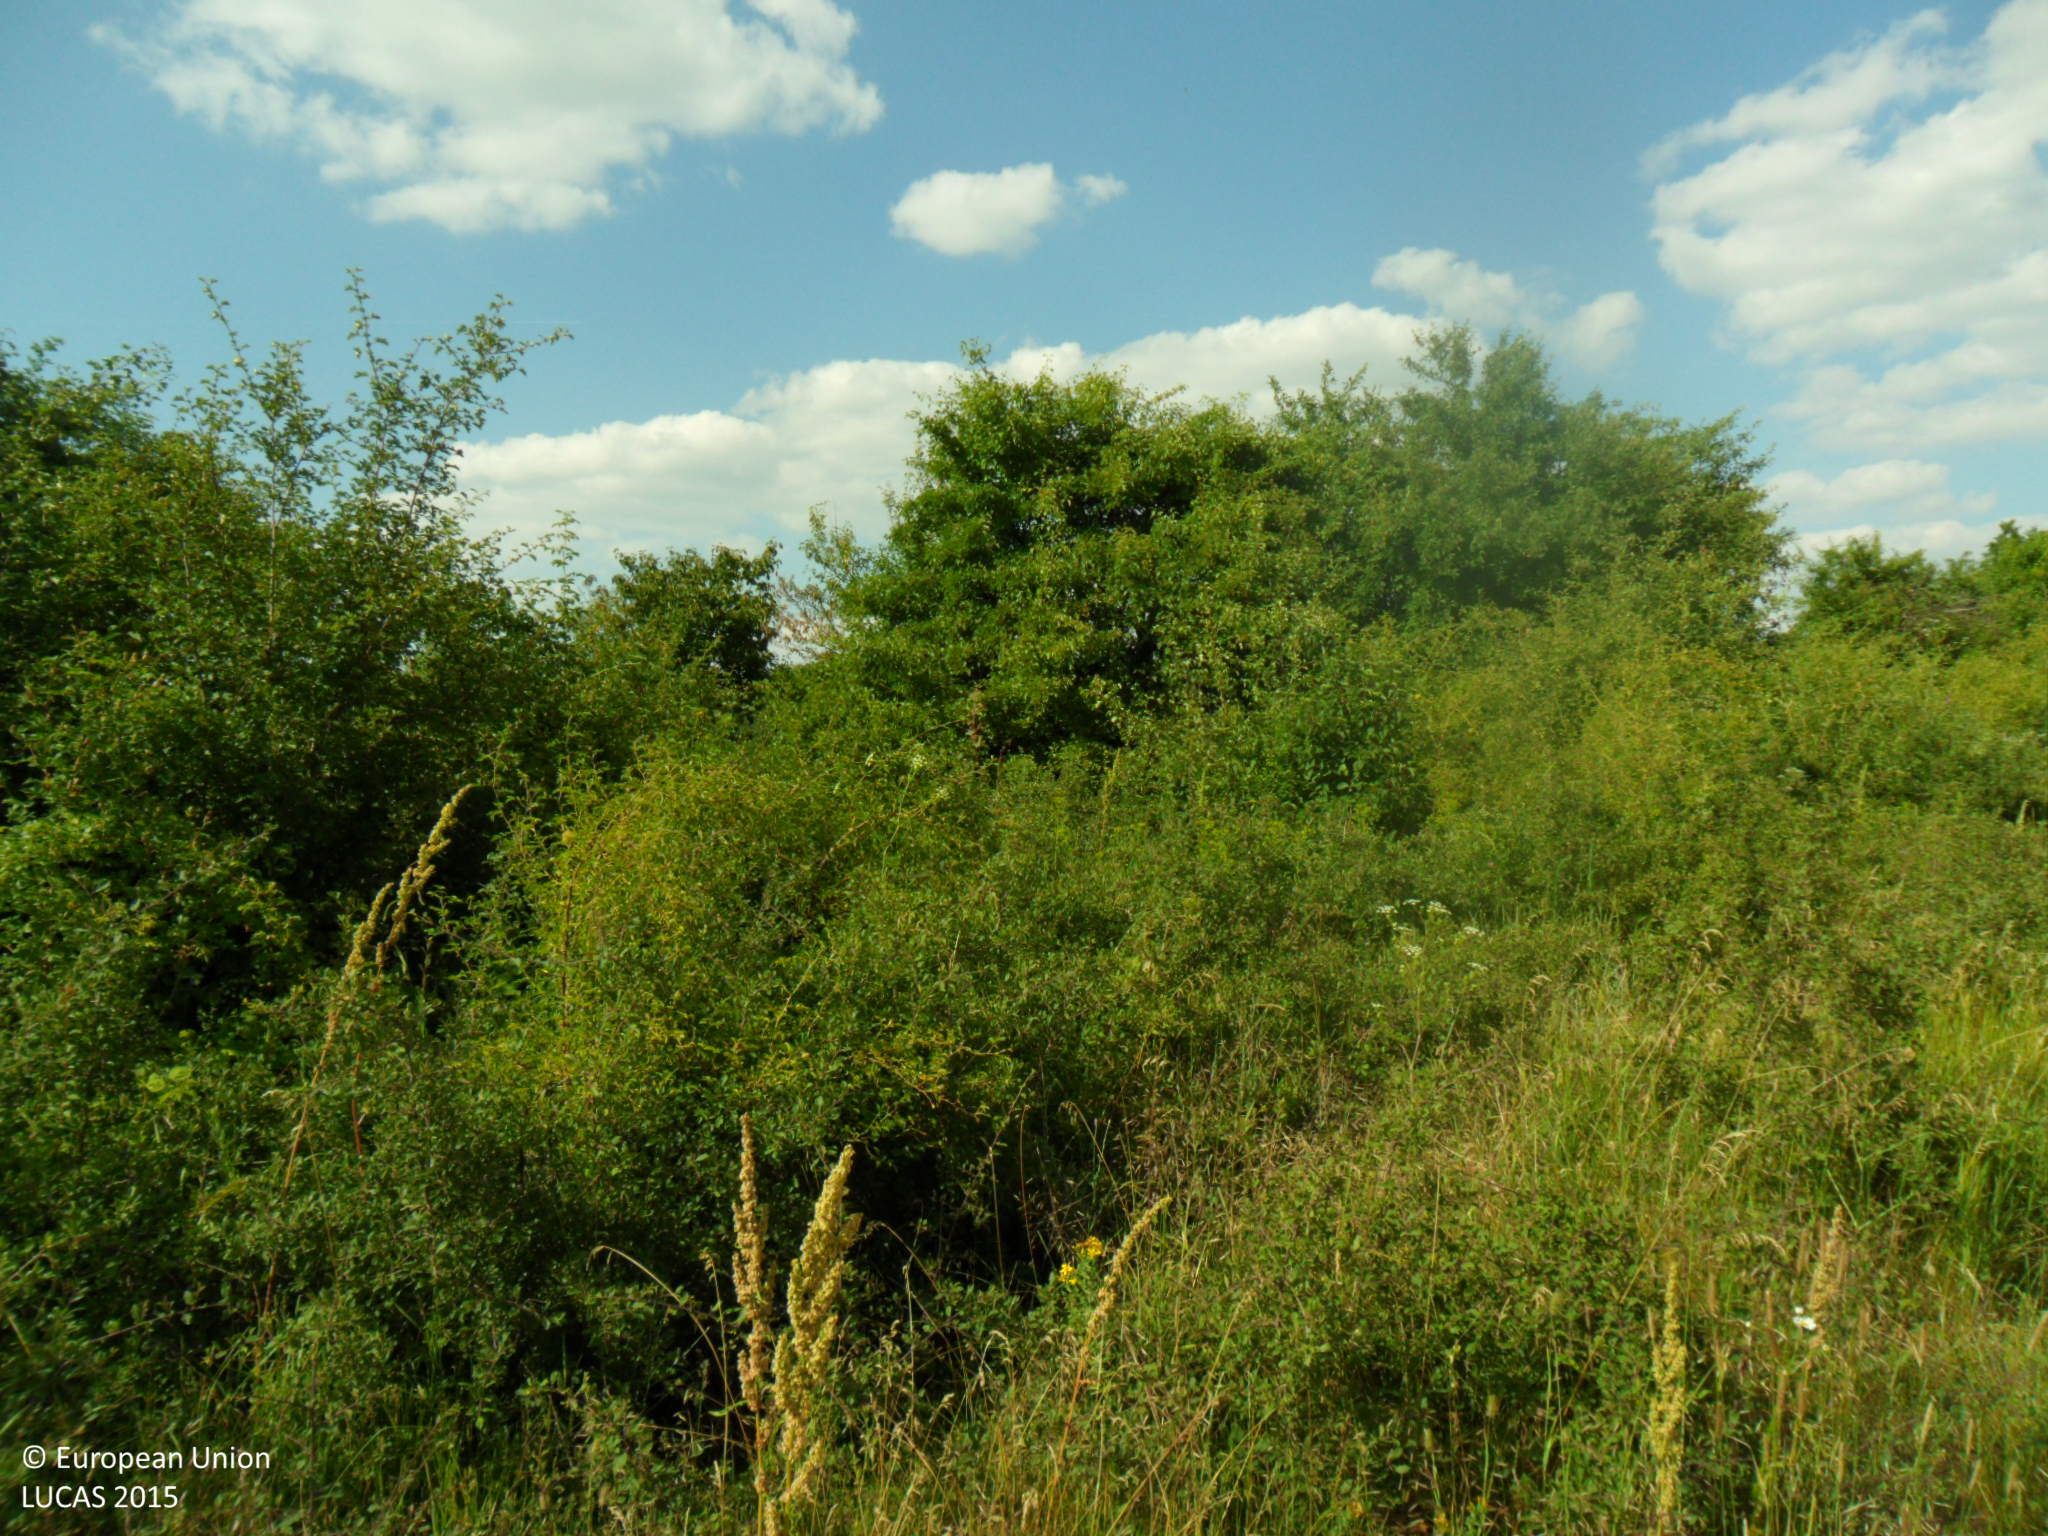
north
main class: Woodland
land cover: Broadleaved woodland
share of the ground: > 75 %
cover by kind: broadleaved forest trees 90 %, shrubs 10 %
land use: Semi-natural and natural areas not in use
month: June
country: BG
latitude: 43.4827
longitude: 26.9176
